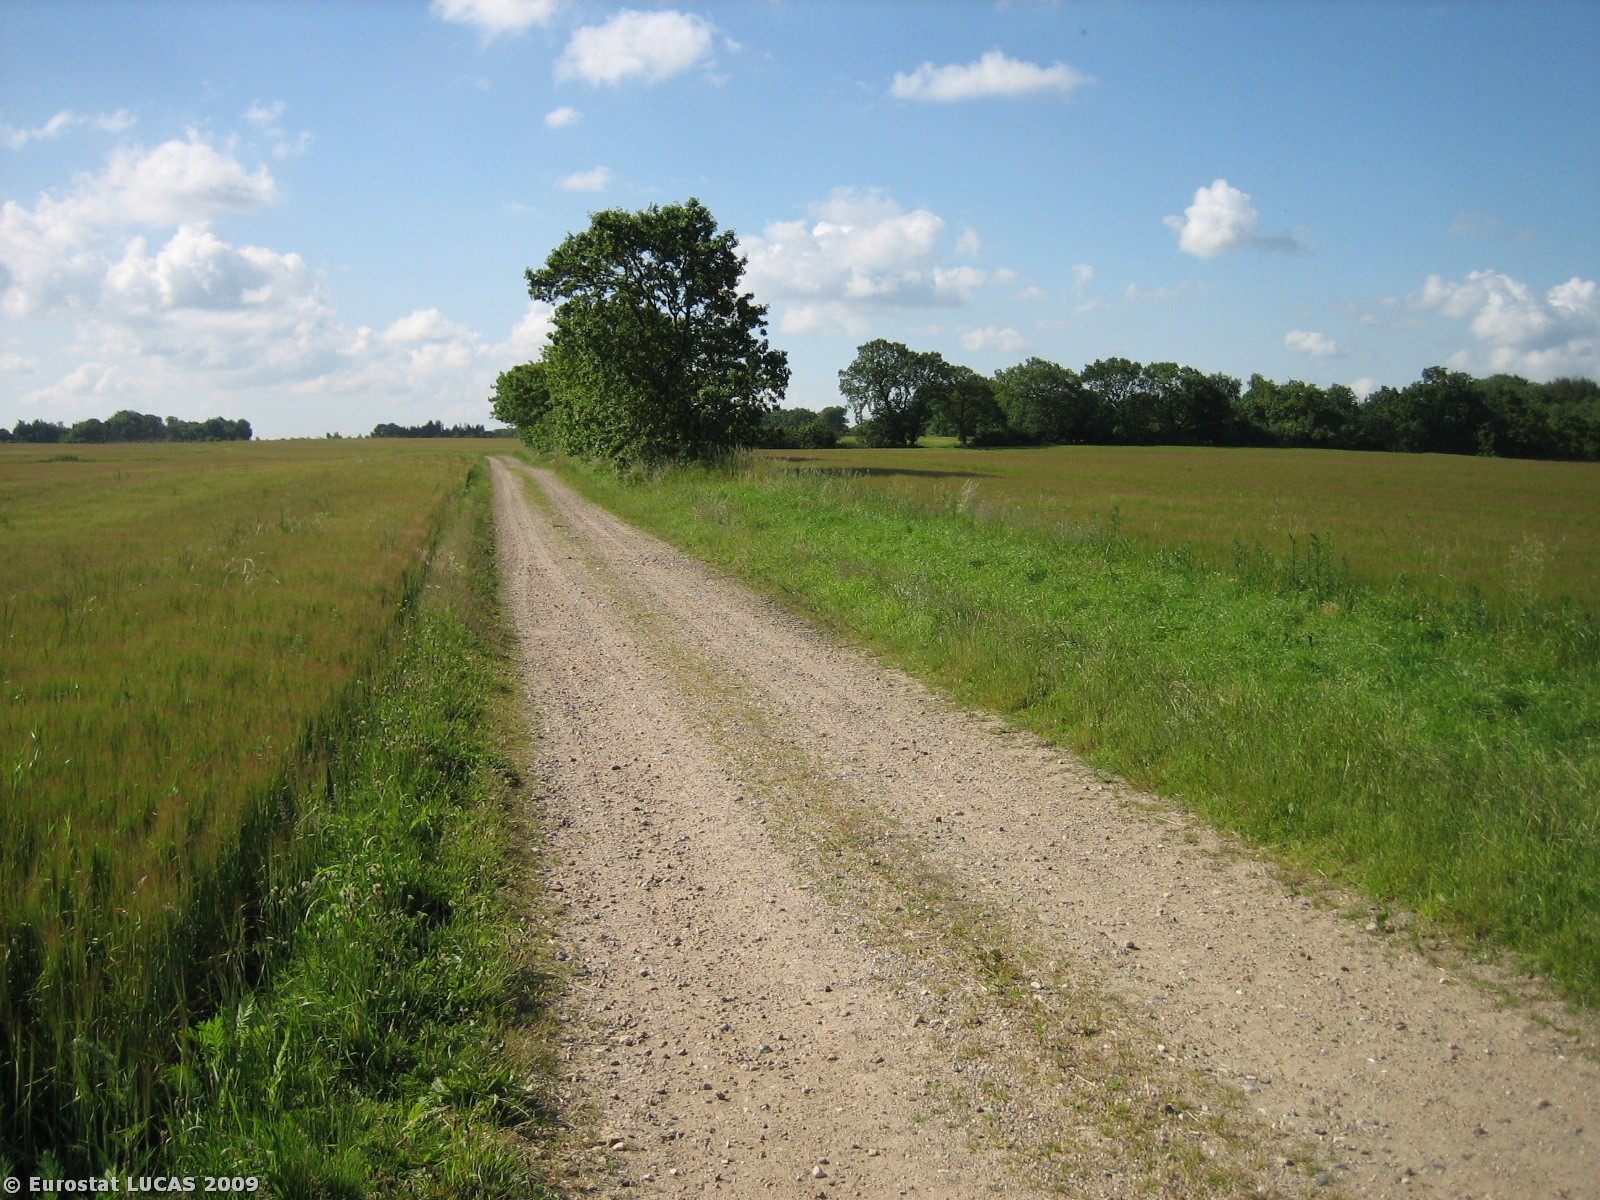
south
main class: Cropland
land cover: Barley
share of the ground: > 75 %
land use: Agriculture (excluding fallow land and kitchen gardens)
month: June
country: DK
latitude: 55.5207
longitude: 9.2879
